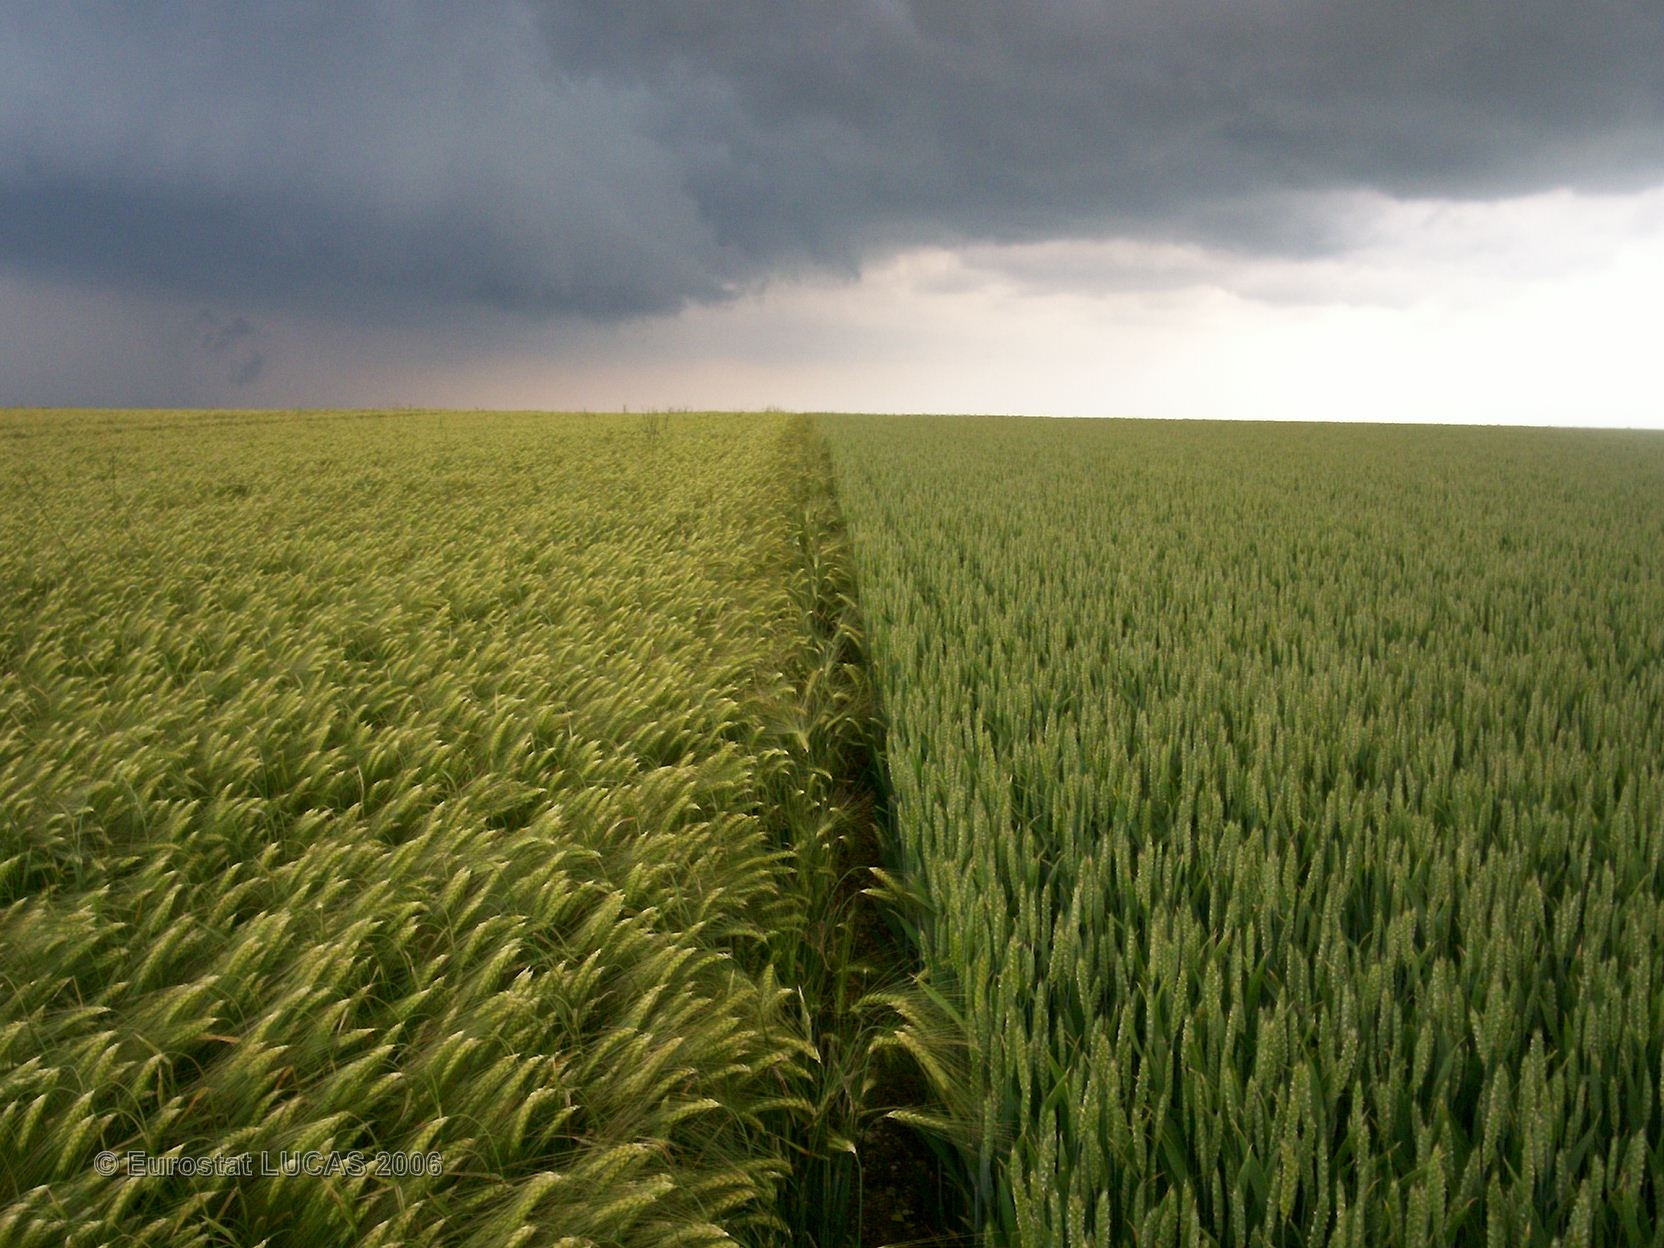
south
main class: Cropland
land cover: Barley
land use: Agriculture (excluding fallow land and kitchen gardens)
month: June
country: FR
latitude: 48.6068
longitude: 4.4500
